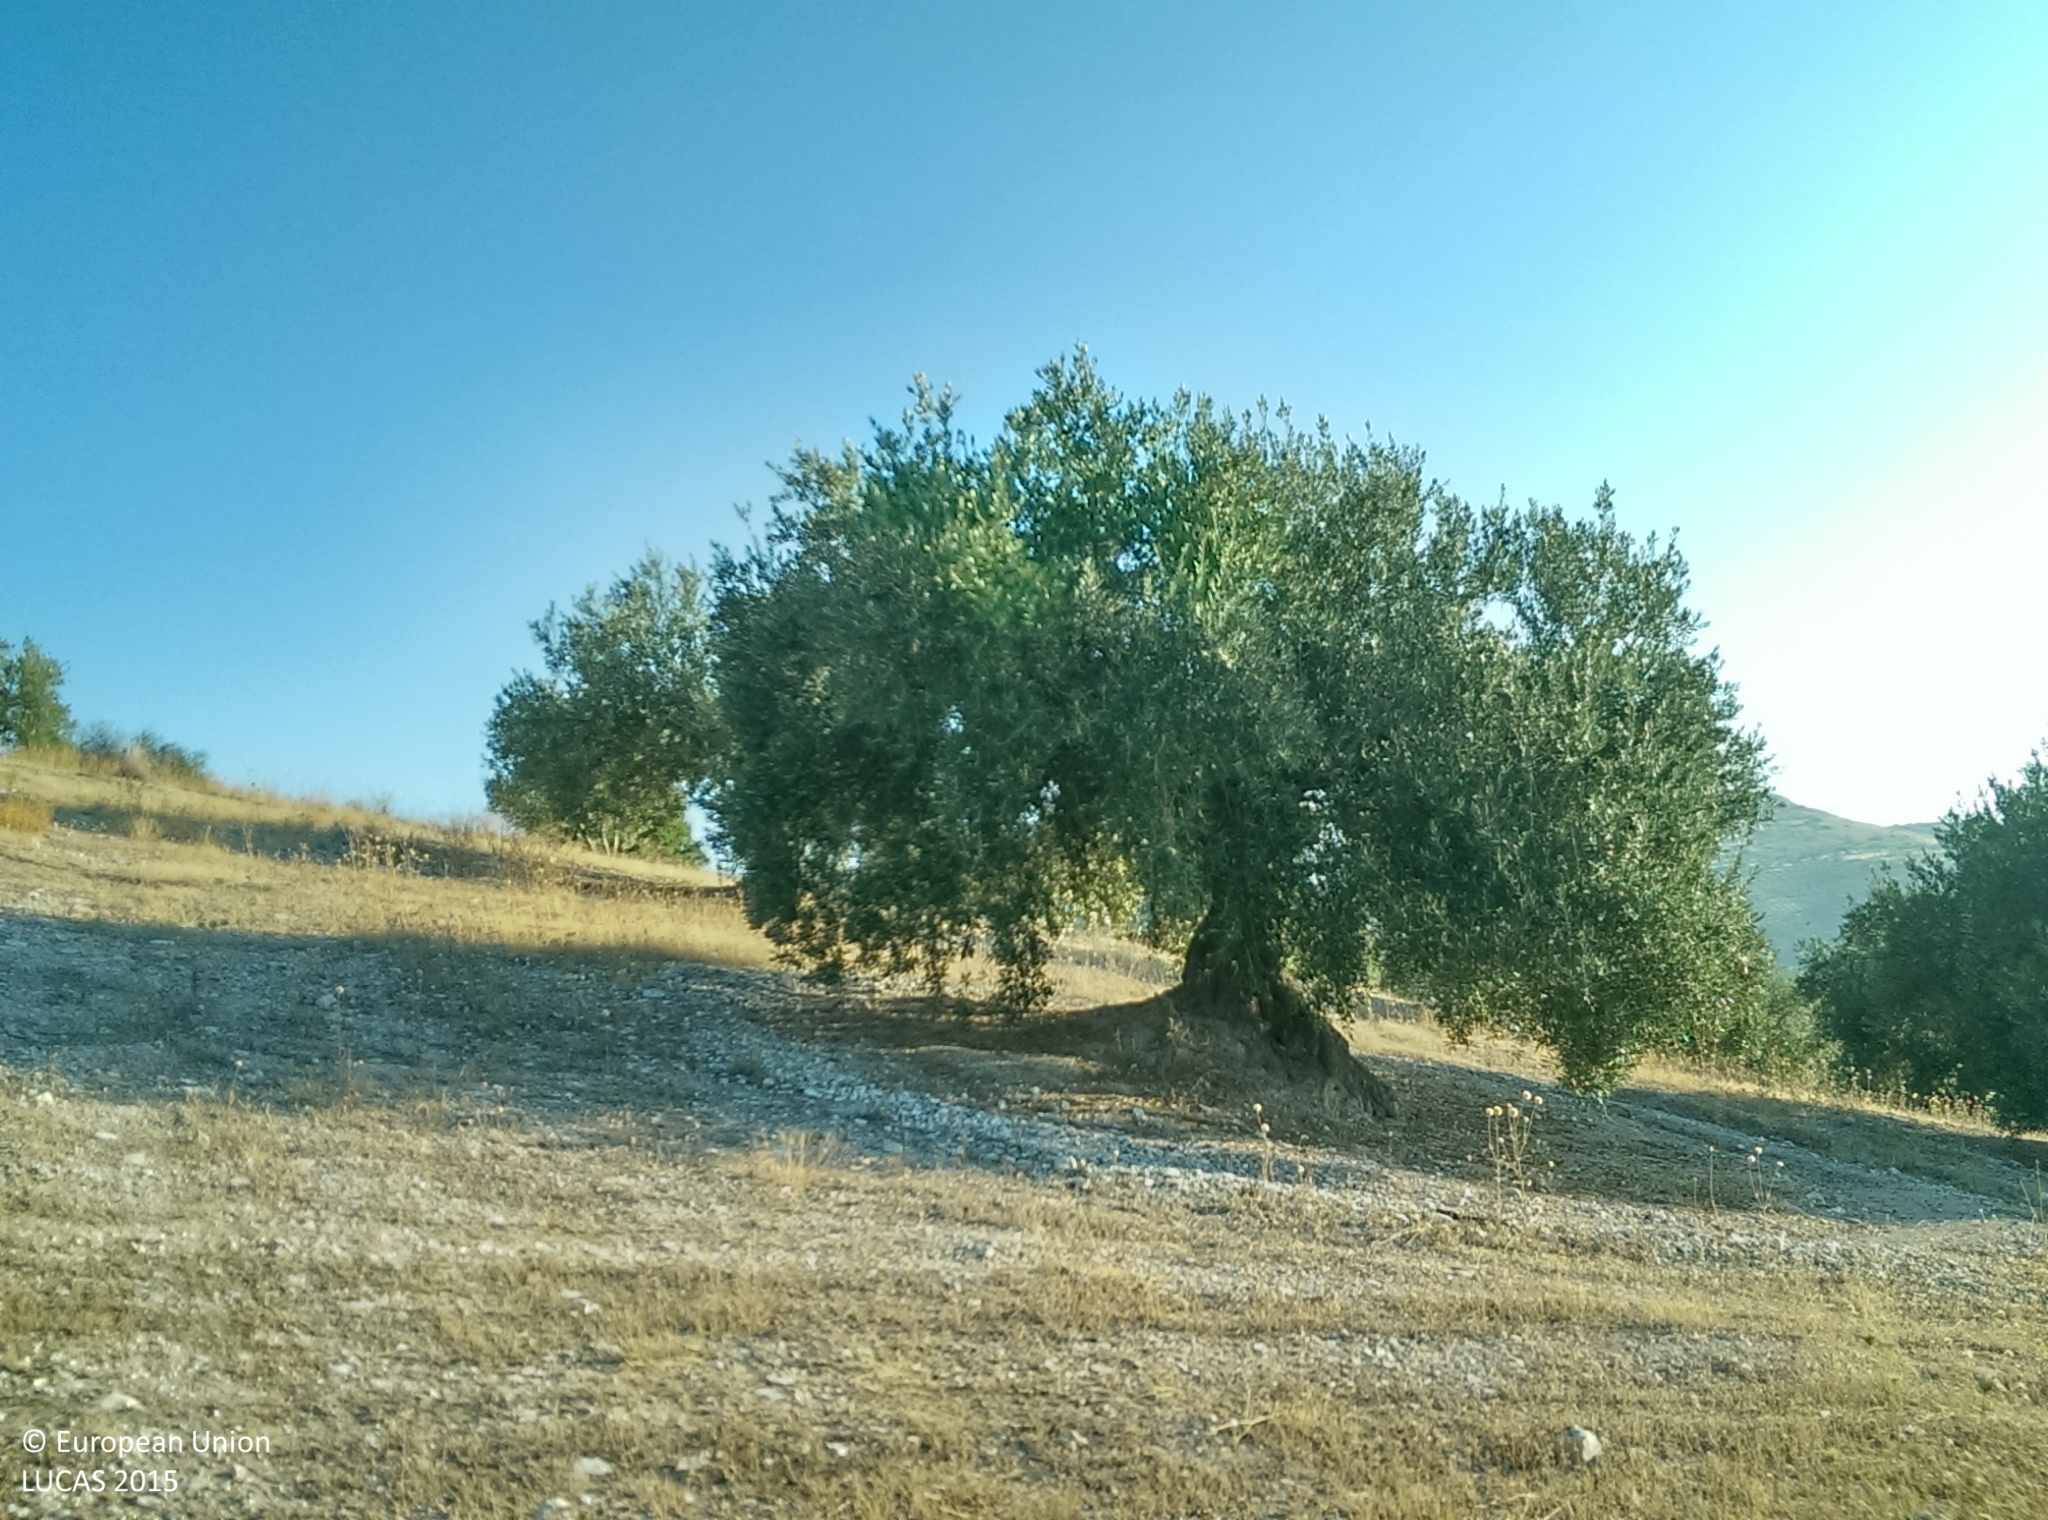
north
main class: Cropland
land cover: Olive groves
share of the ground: 25 - 50 %
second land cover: Spontaneously vegetated surfaces
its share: 10 - 25 %
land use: Agriculture (excluding fallow land and kitchen gardens)
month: July
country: ES
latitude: 37.3554
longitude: -3.7103
